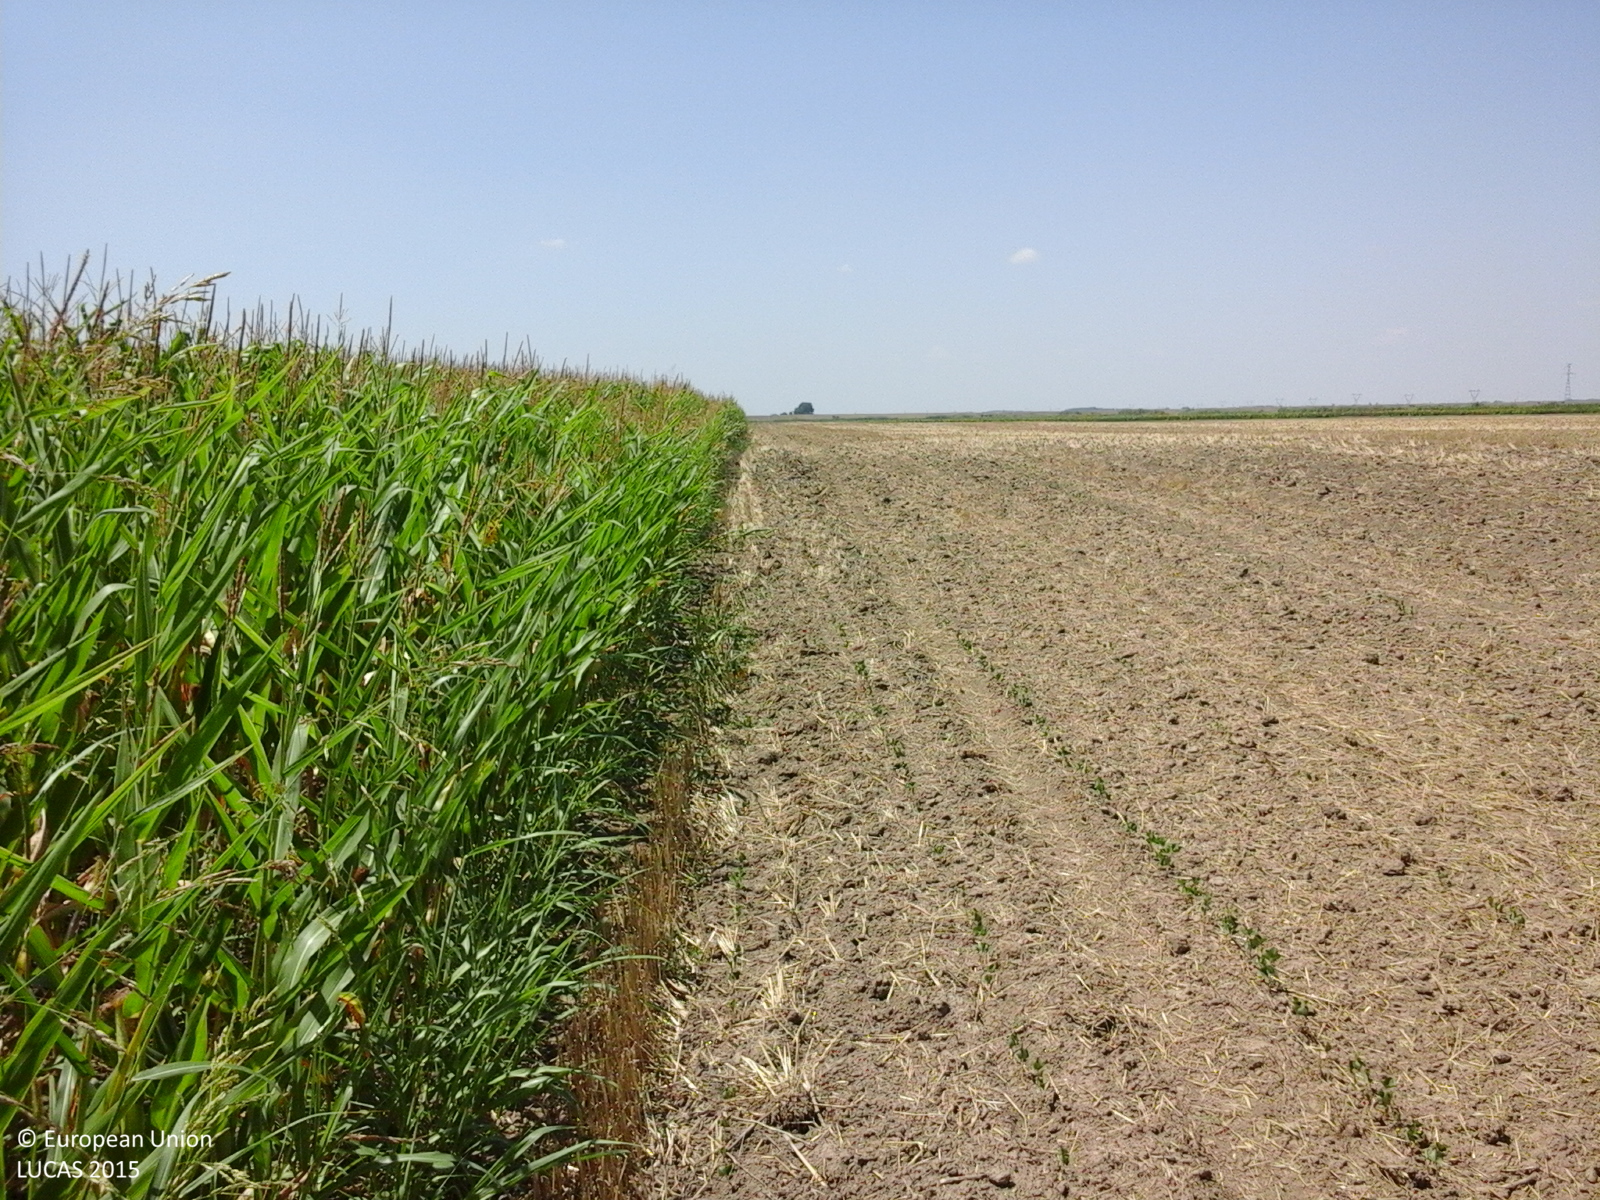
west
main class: Cropland
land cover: Maize
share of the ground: > 75 %
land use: Agriculture (excluding fallow land and kitchen gardens)
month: July
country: RO
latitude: 44.1903
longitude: 26.9770
